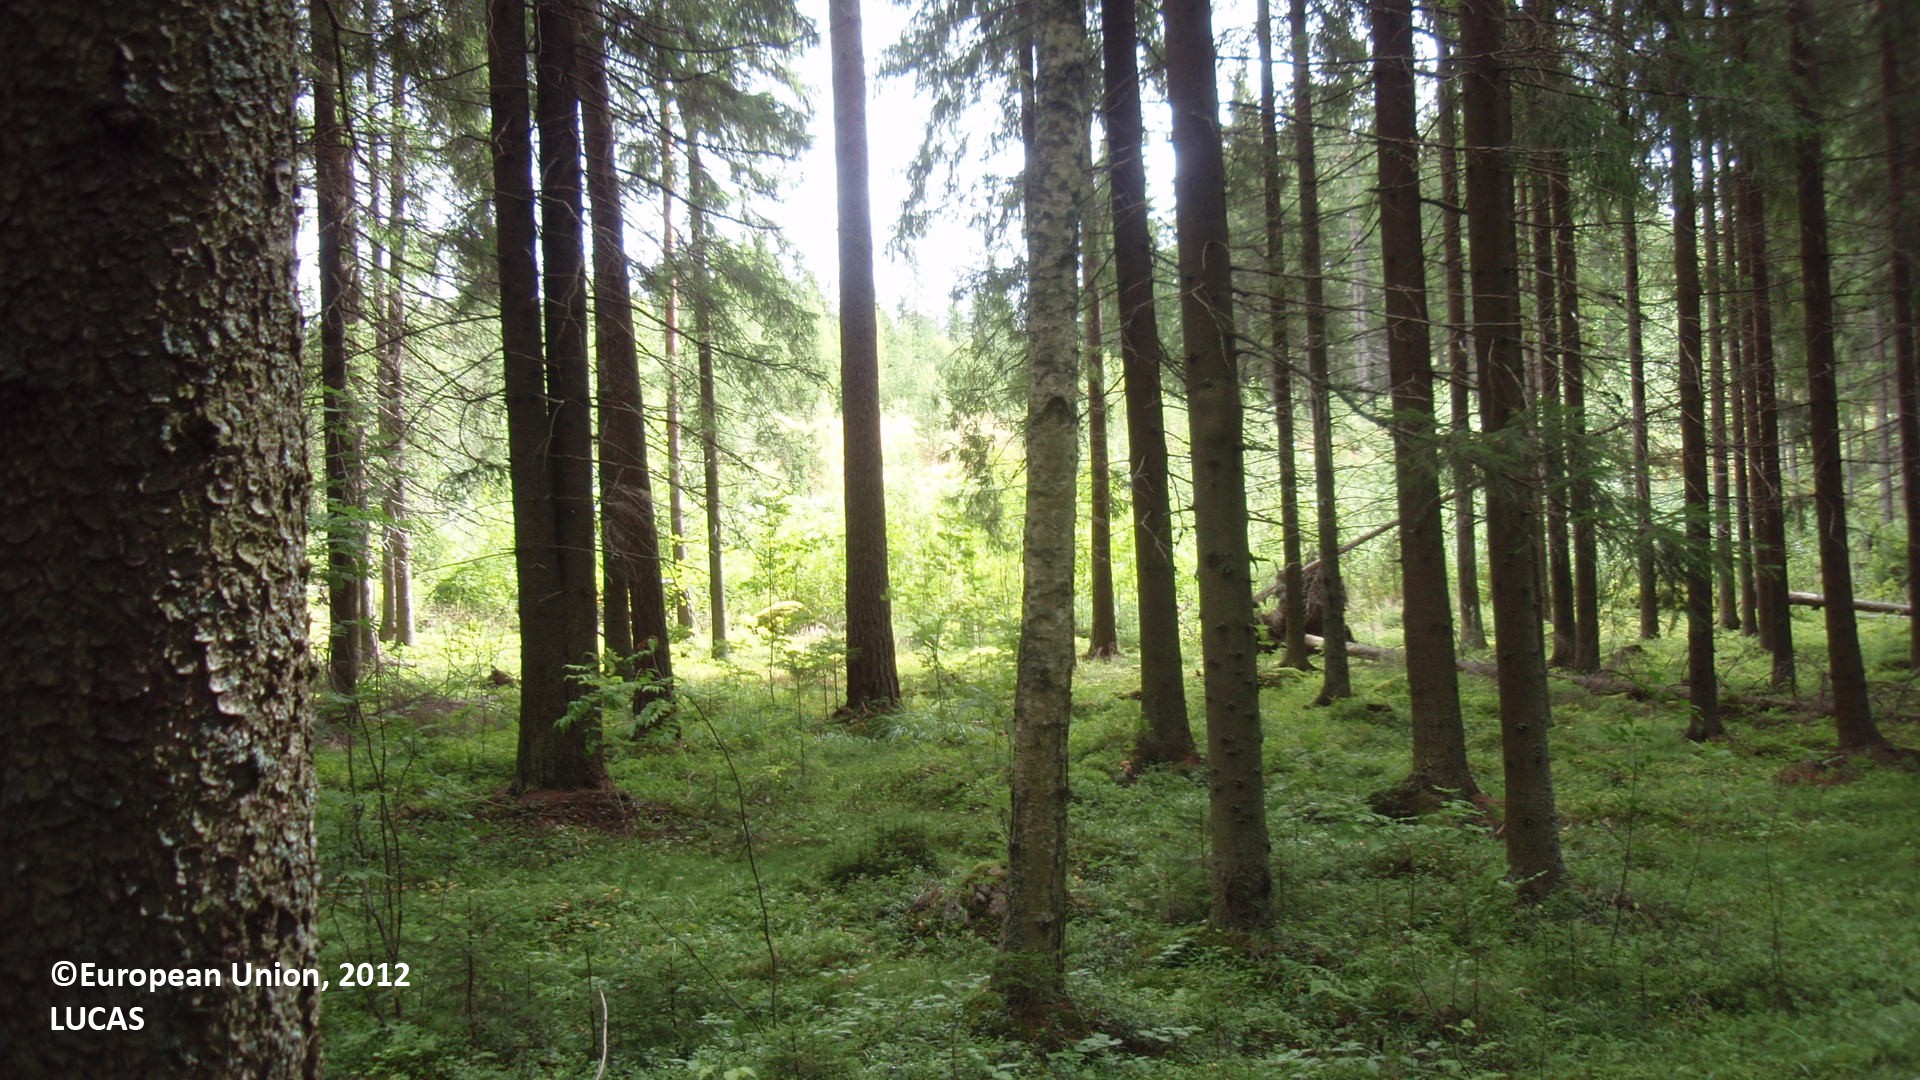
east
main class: Woodland
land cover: Spruce dominated mixed woodland
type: boreal forest
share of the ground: 50 - 75 %
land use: Agriculture (excluding fallow land and kitchen gardens)
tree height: > 5 m
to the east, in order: Spruce dominated mixed woodland; Pine dominated mixed woodland; Broadleaved woodland; Spruce dominated mixed woodland; Pine dominated mixed woodland; Spruce dominated mixed woodland
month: August
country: FI
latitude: 61.0373
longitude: 27.4908
